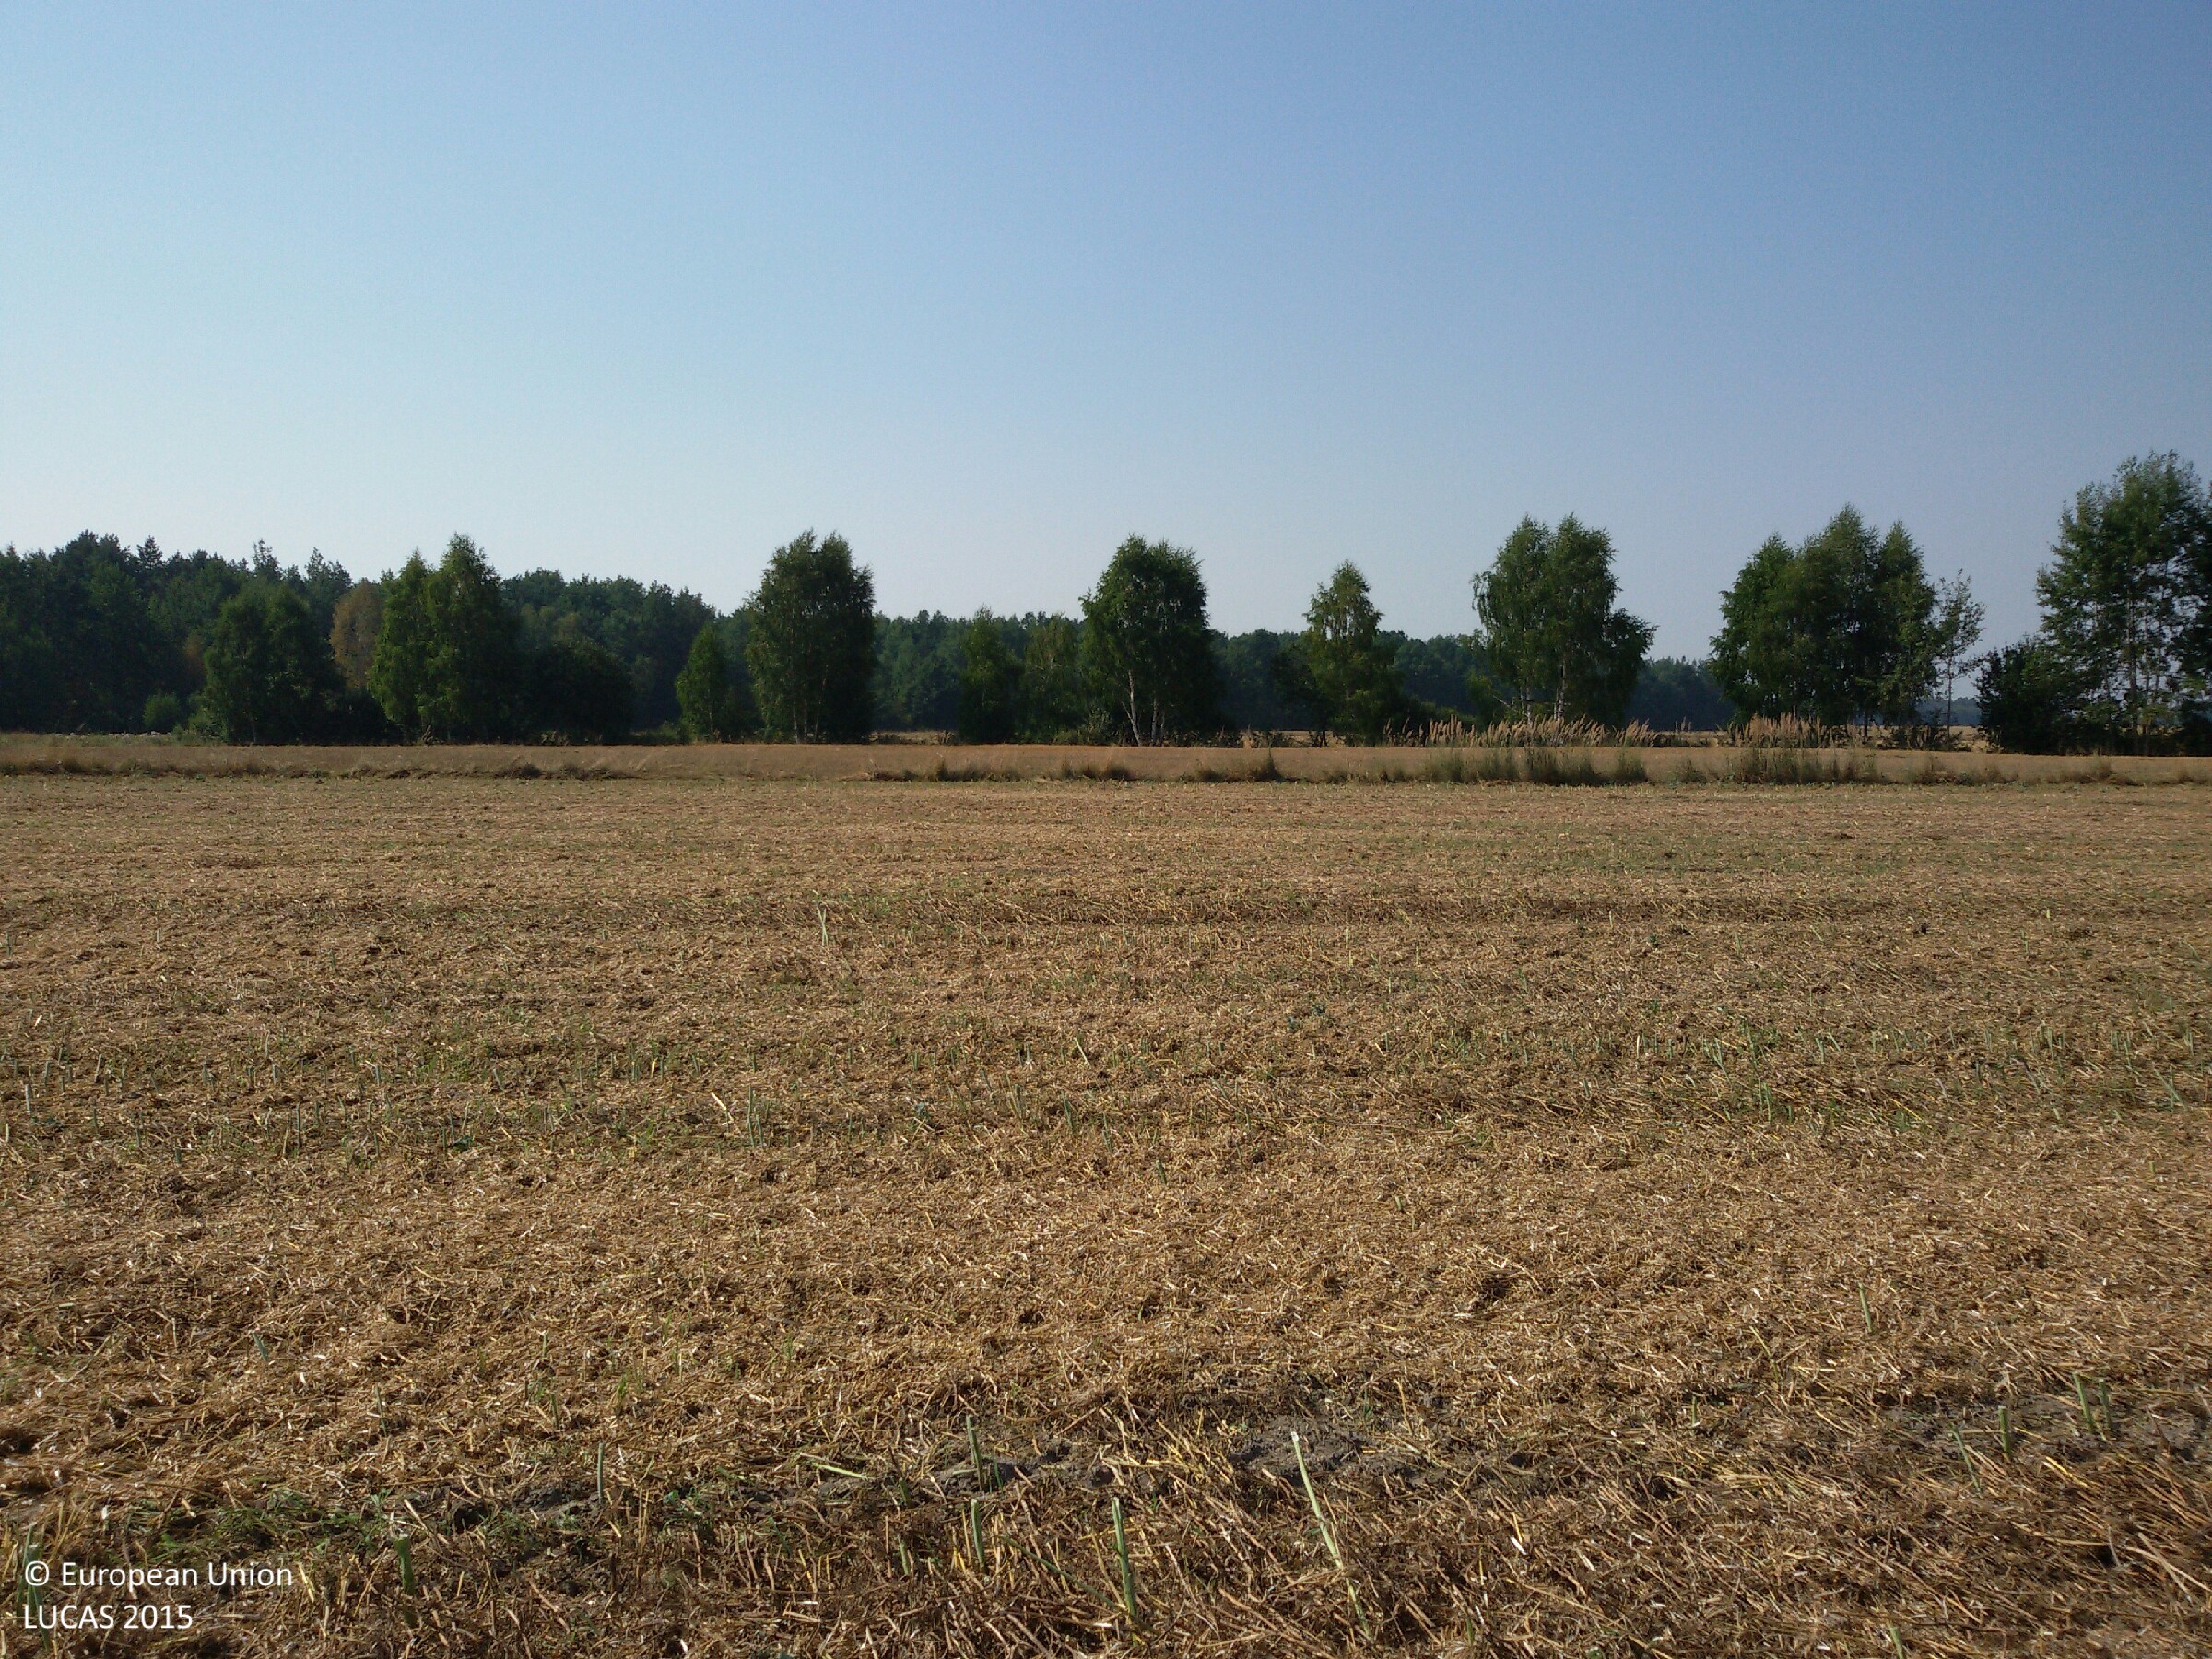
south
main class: Cropland
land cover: Barley
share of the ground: 50 - 75 %
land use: Agriculture (excluding fallow land and kitchen gardens)
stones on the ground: < 10 %
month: August
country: PL
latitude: 51.6763
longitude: 22.8418
